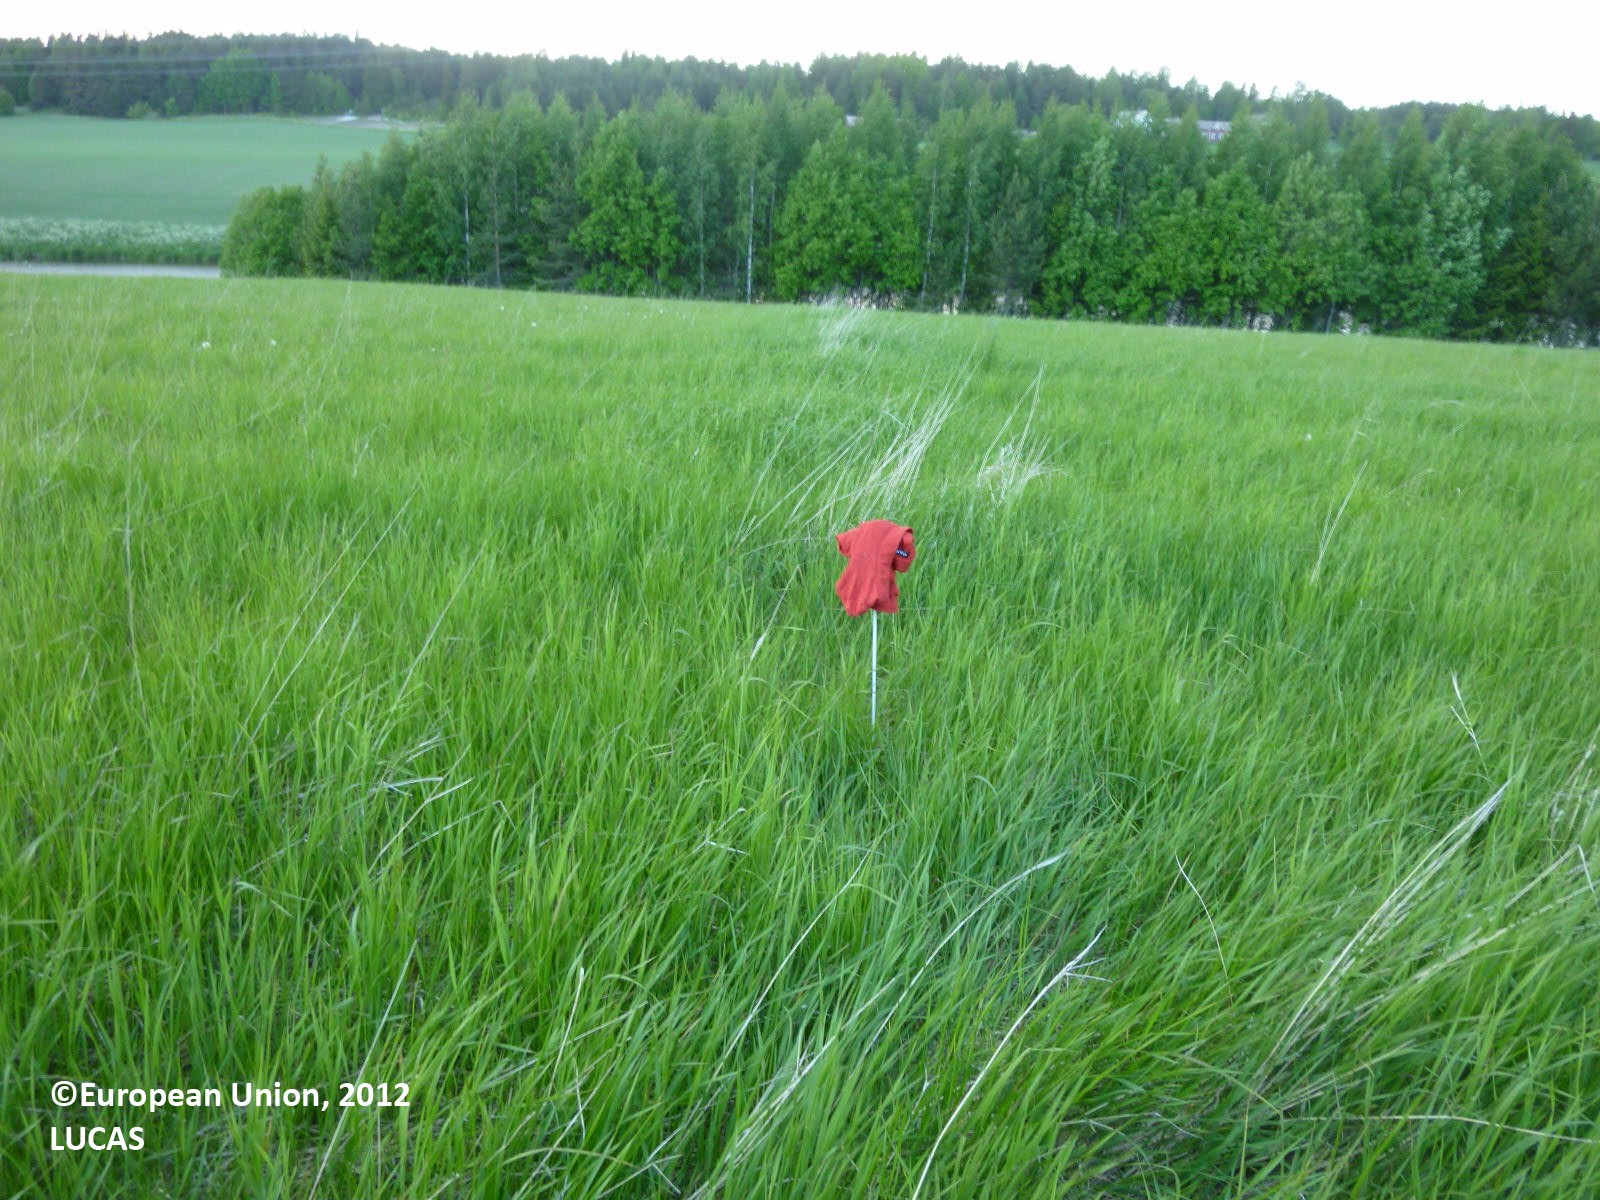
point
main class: Grassland
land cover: Grassland without tree/shrub cover
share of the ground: > 75 %
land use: Agriculture (excluding fallow land and kitchen gardens)
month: June
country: FI
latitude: 60.4900
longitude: 22.3900
